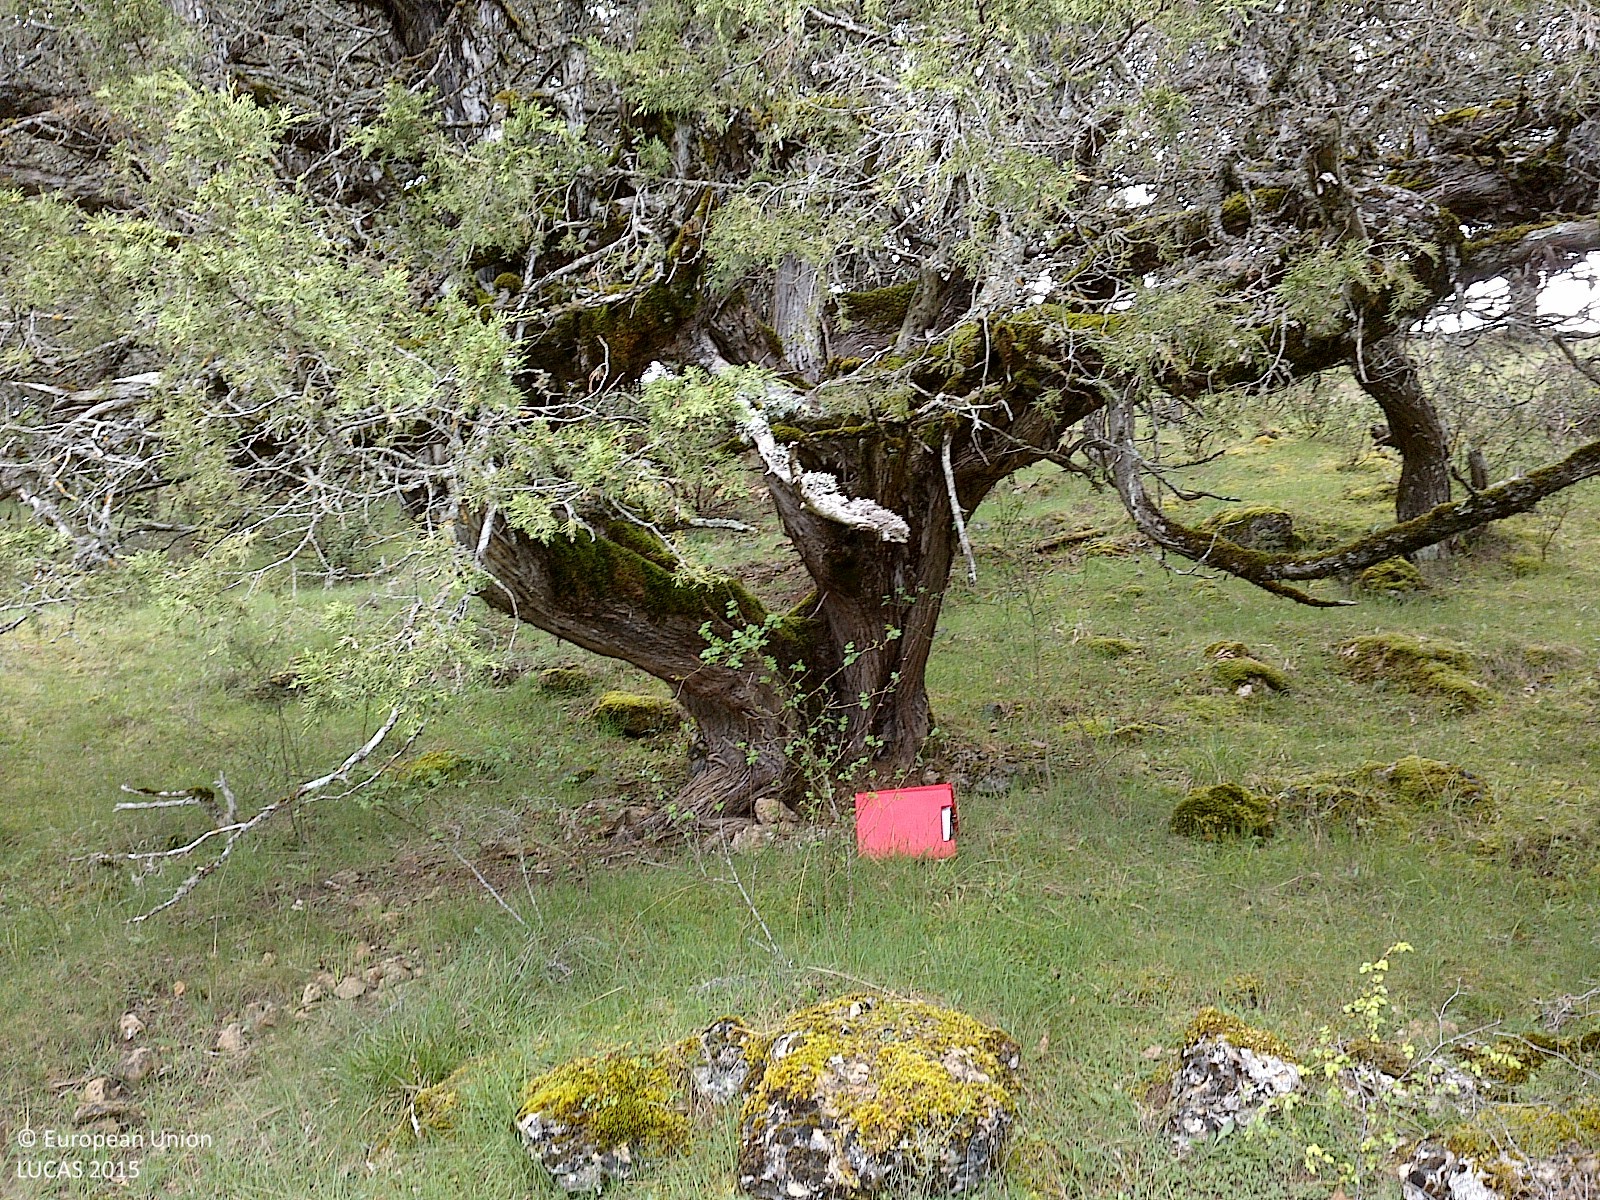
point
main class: Woodland
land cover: Other coniferous woodland
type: coniferous forest of the mediterranean region
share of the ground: 50 - 75 %
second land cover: Grassland without tree/shrub cover
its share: > 75 %
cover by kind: coniferous forest trees 55 %, herbaceous plants 40 %, shrubs 5 %
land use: Forestry
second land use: Agriculture (excluding fallow land and kitchen gardens)
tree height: > 5 m
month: May
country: ES
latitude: 41.9491
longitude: -3.2101
